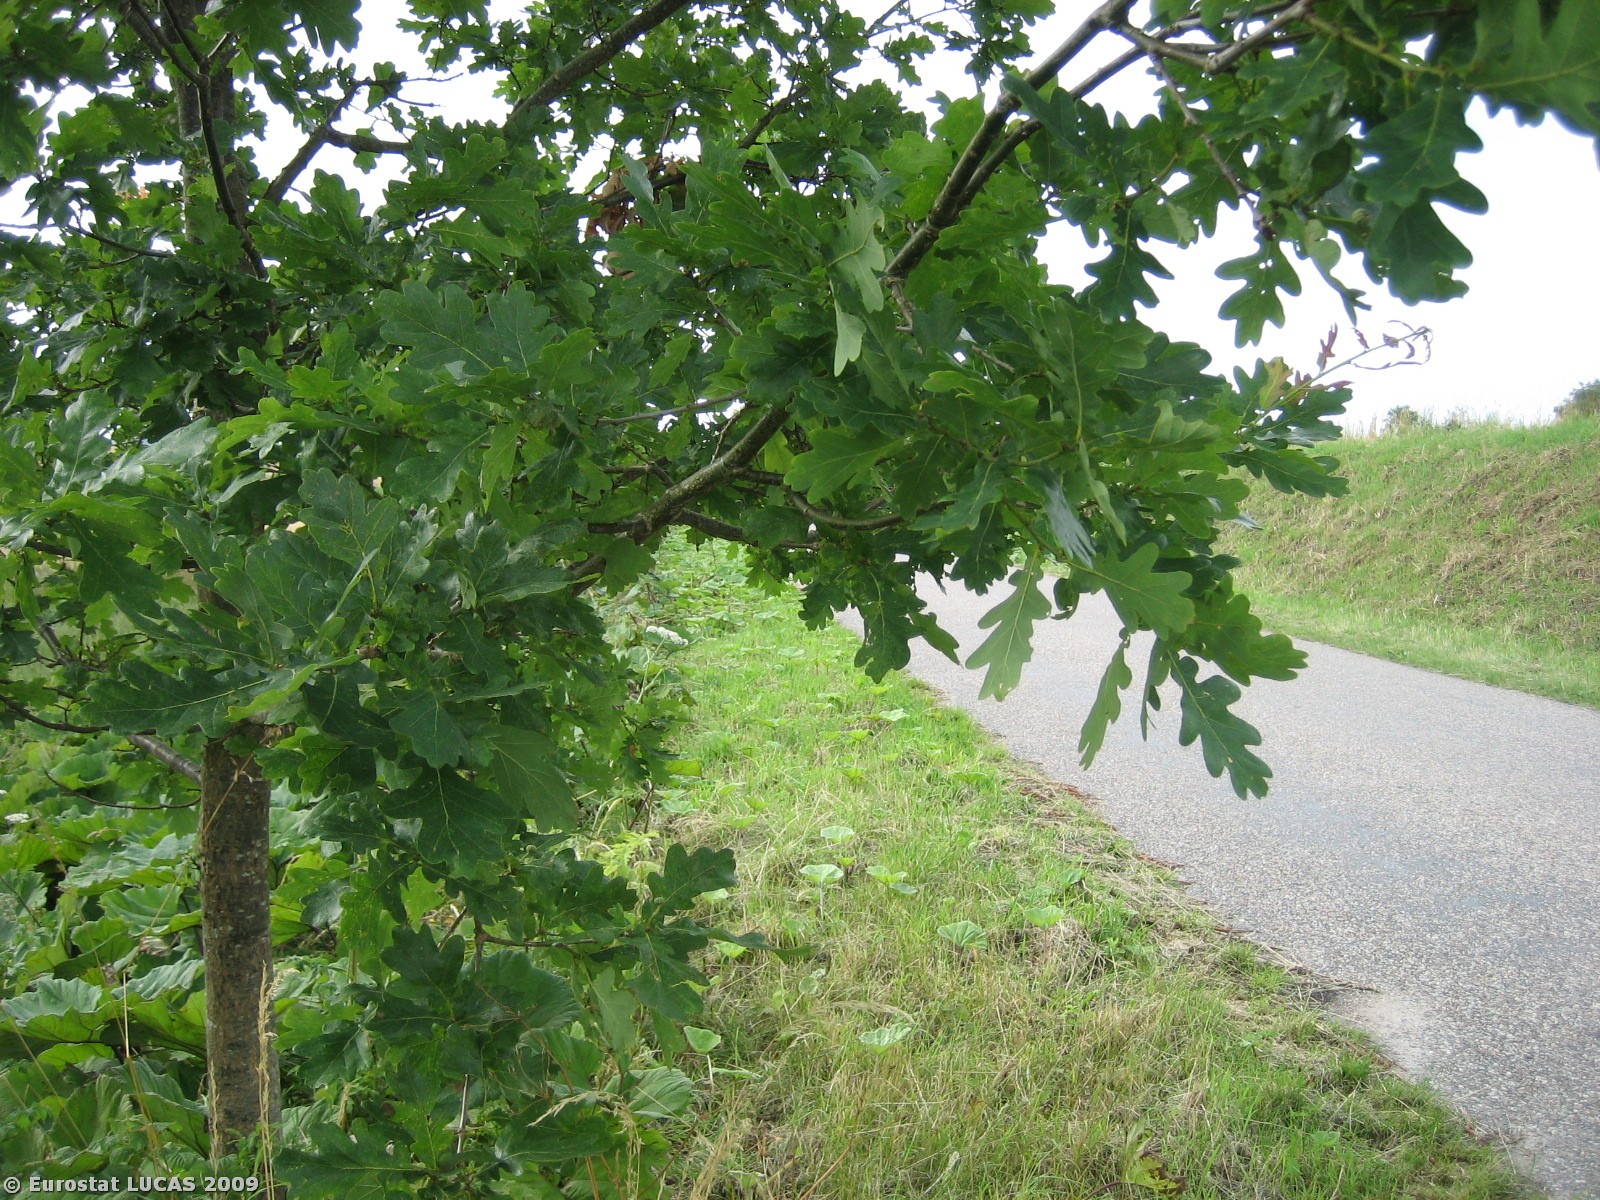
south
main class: Grassland
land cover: Grassland with sparse tree/shrub cover
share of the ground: > 75 %
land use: Unused
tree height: > 5 m
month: July
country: DK
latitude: 55.2171
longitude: 9.9843
